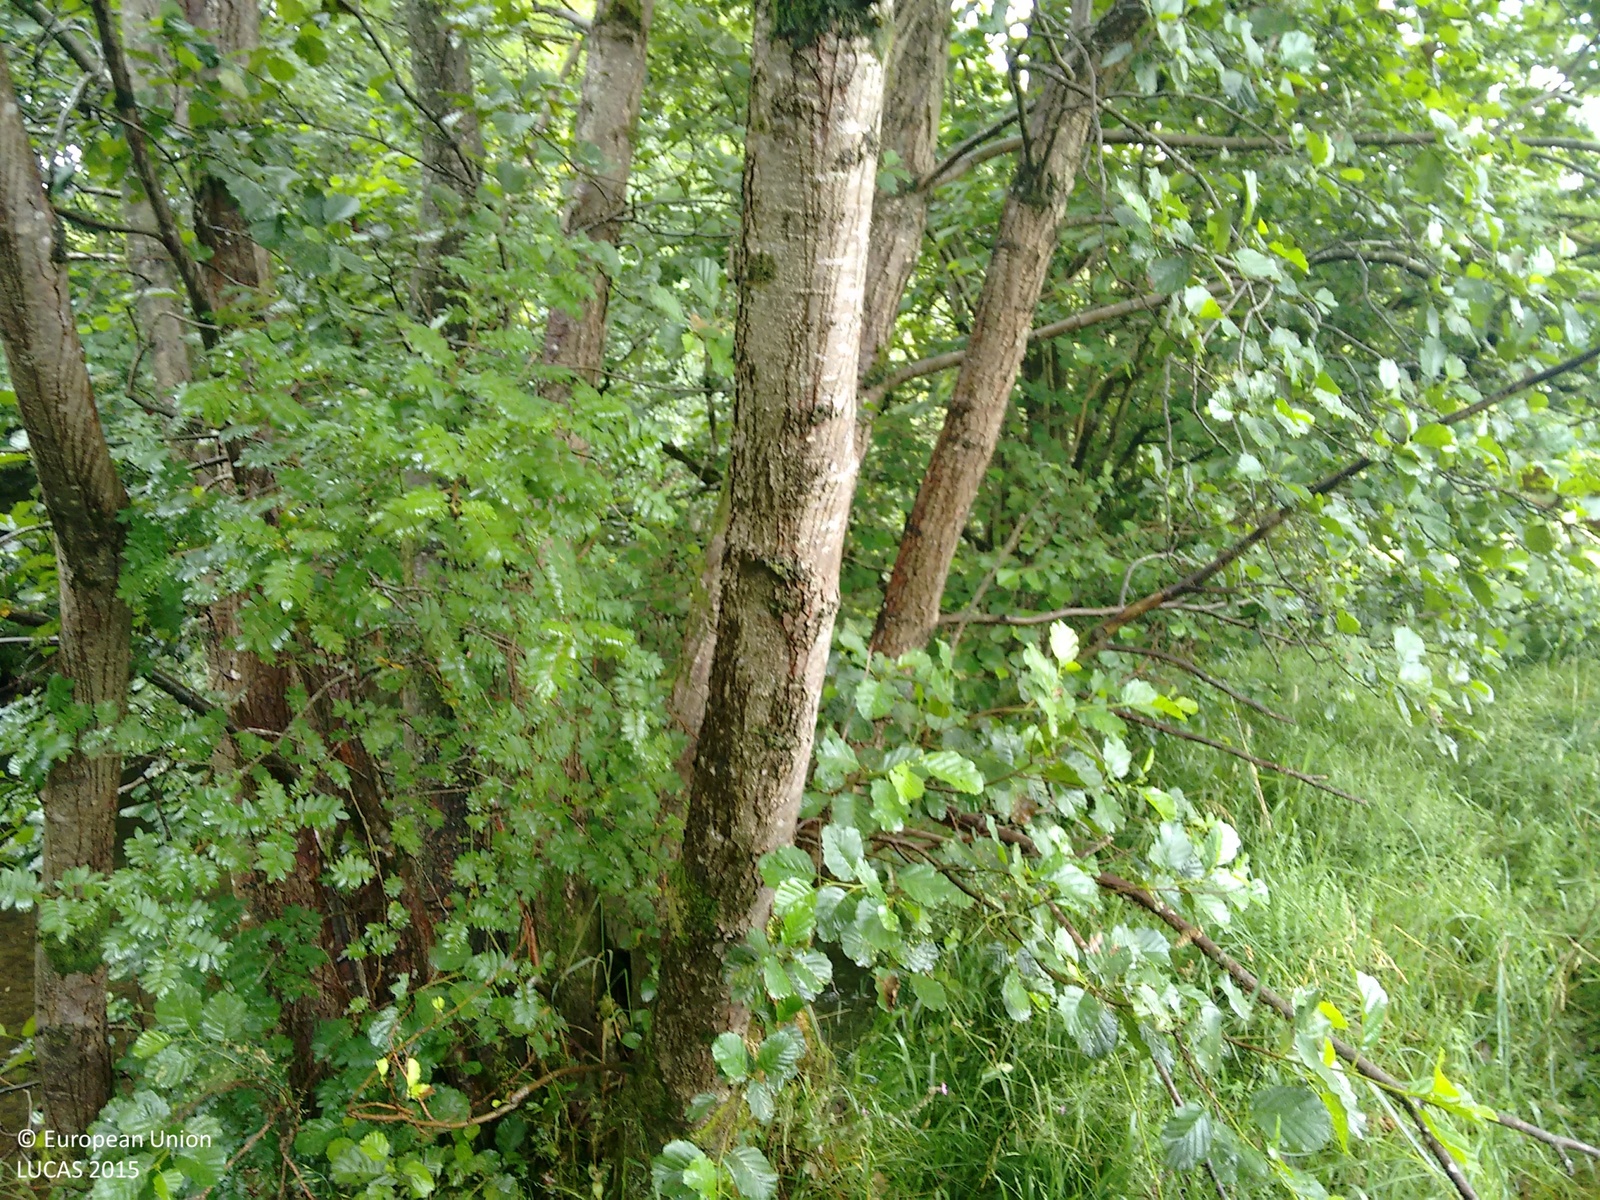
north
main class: Woodland
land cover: Broadleaved woodland
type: floodplain forest
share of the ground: > 75 %
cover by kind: broadleaved forest trees 100 %
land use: Semi-natural and natural areas not in use
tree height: > 5 m
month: August
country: GB
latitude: 55.3138
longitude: -3.4238
